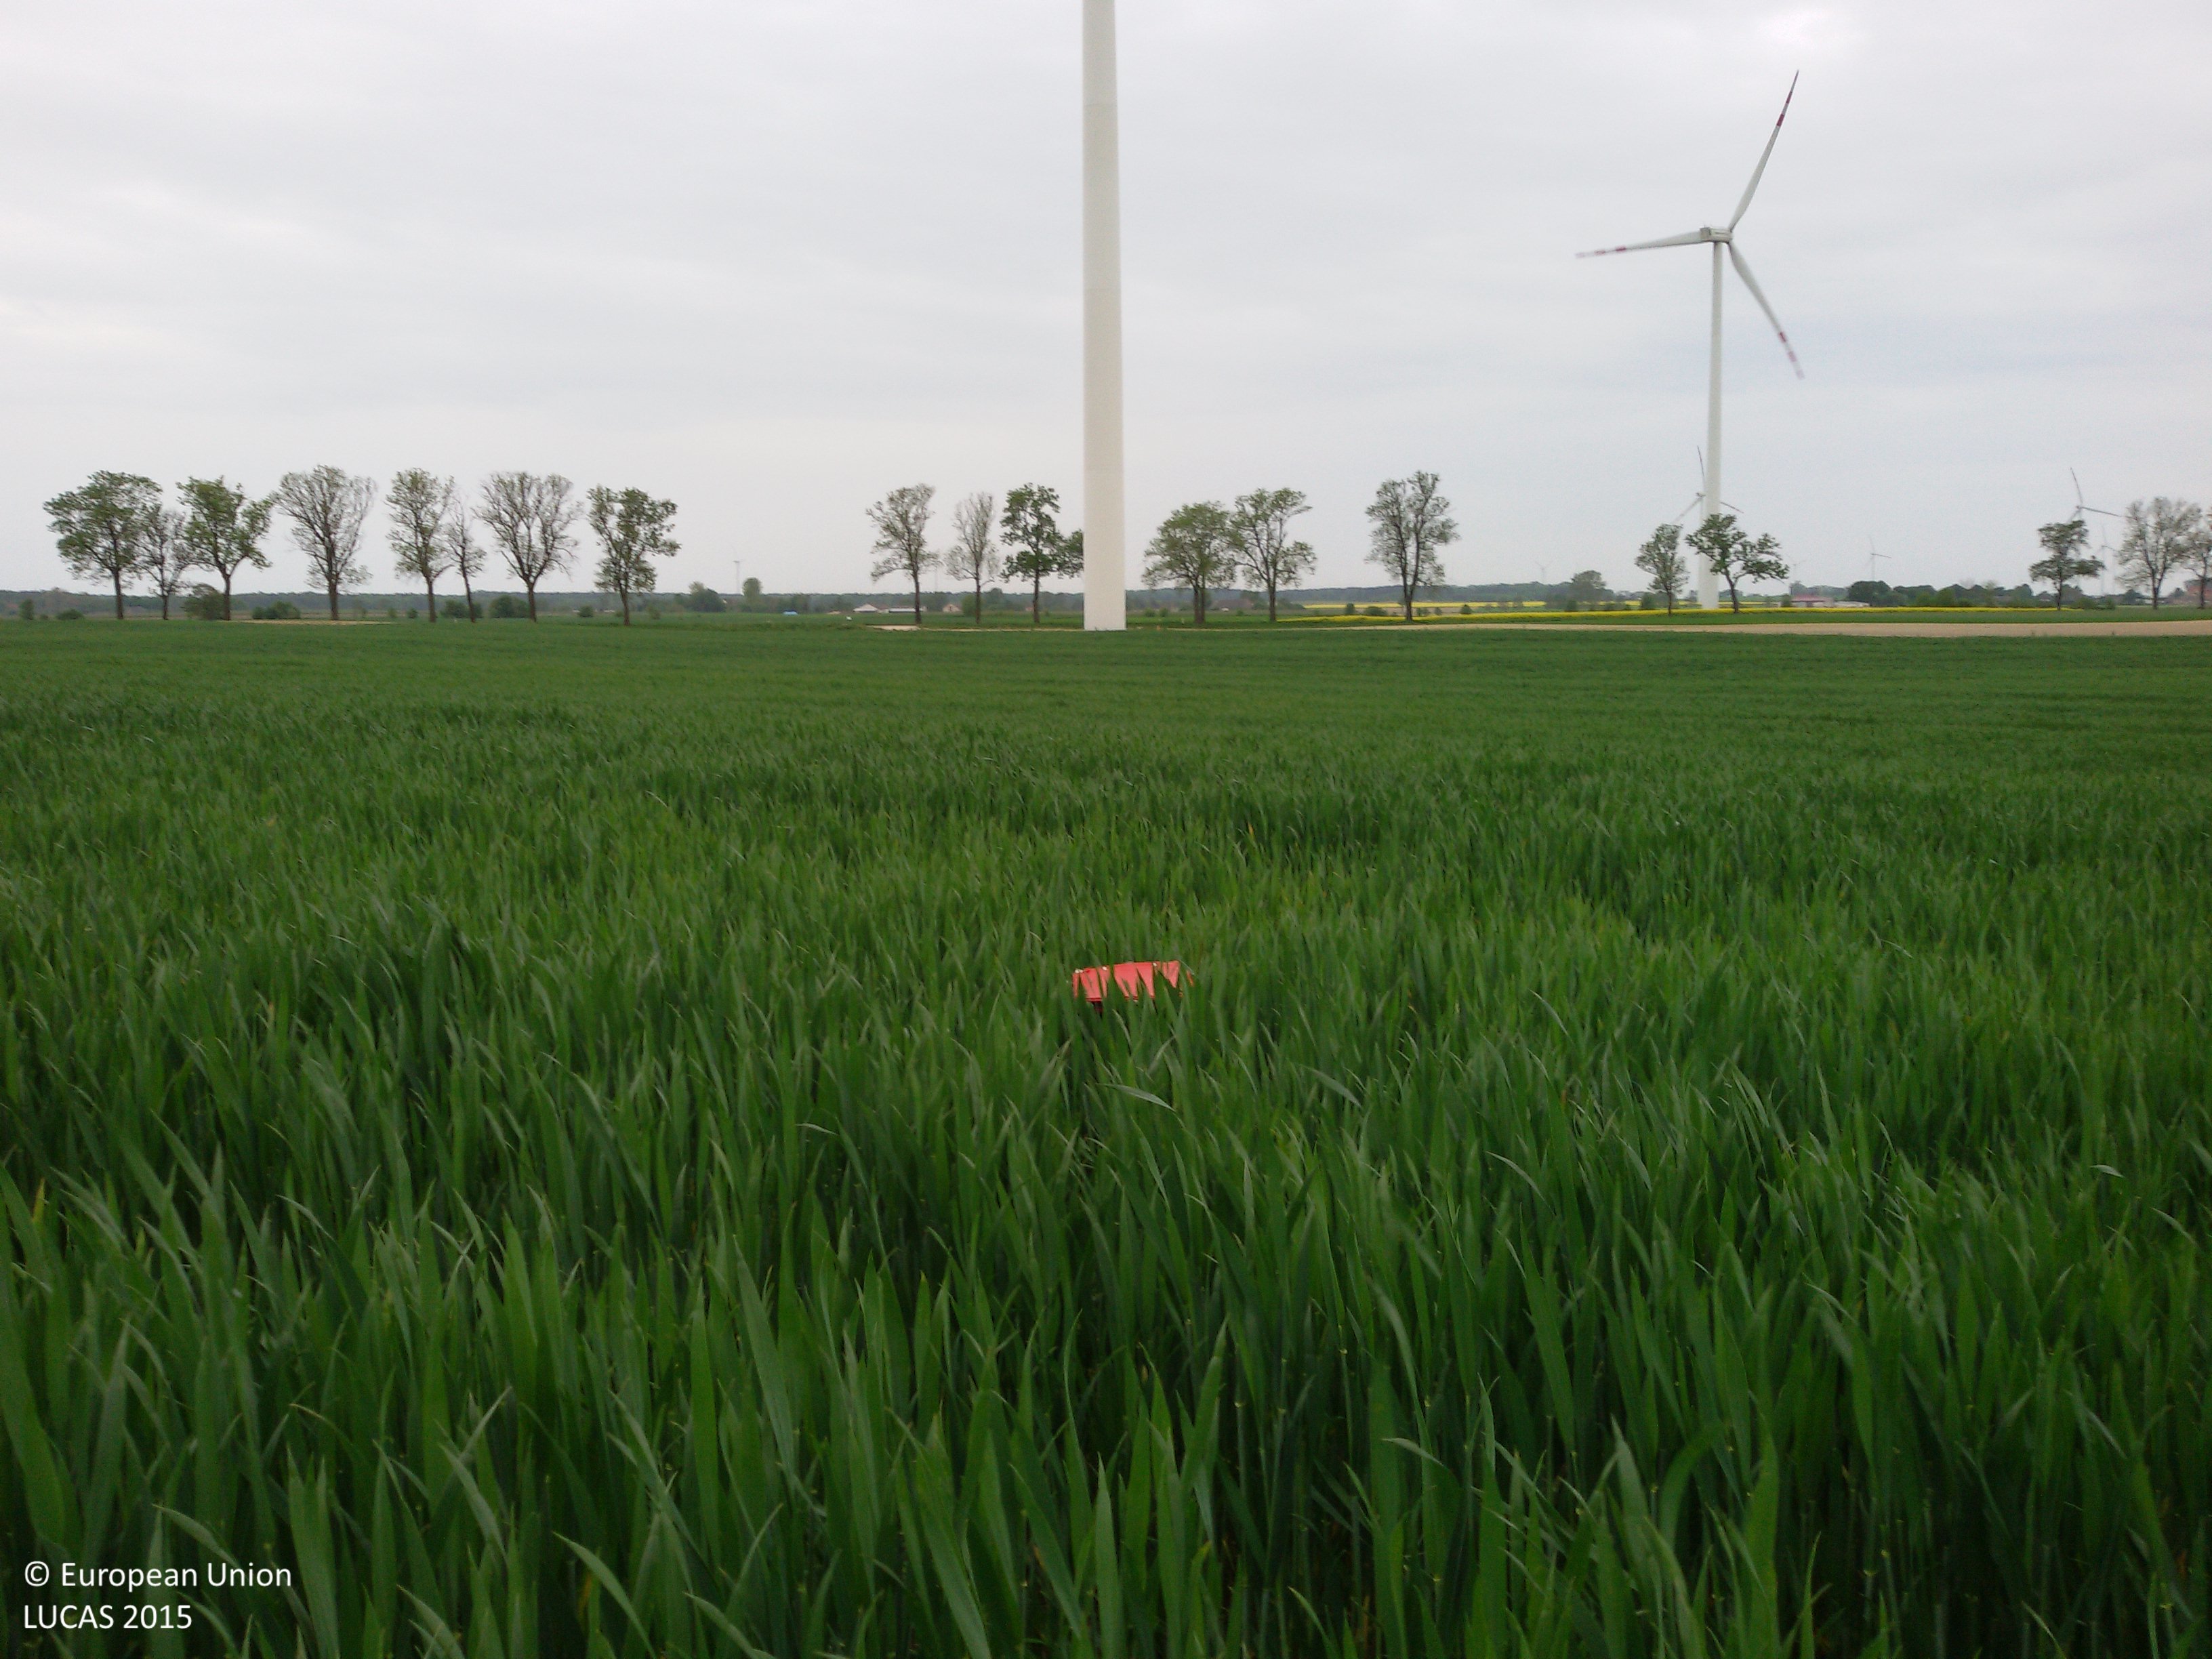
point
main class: Cropland
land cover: Common wheat
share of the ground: > 75 %
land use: Agriculture (excluding fallow land and kitchen gardens)
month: May
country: PL
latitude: 52.9708
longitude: 17.2026
